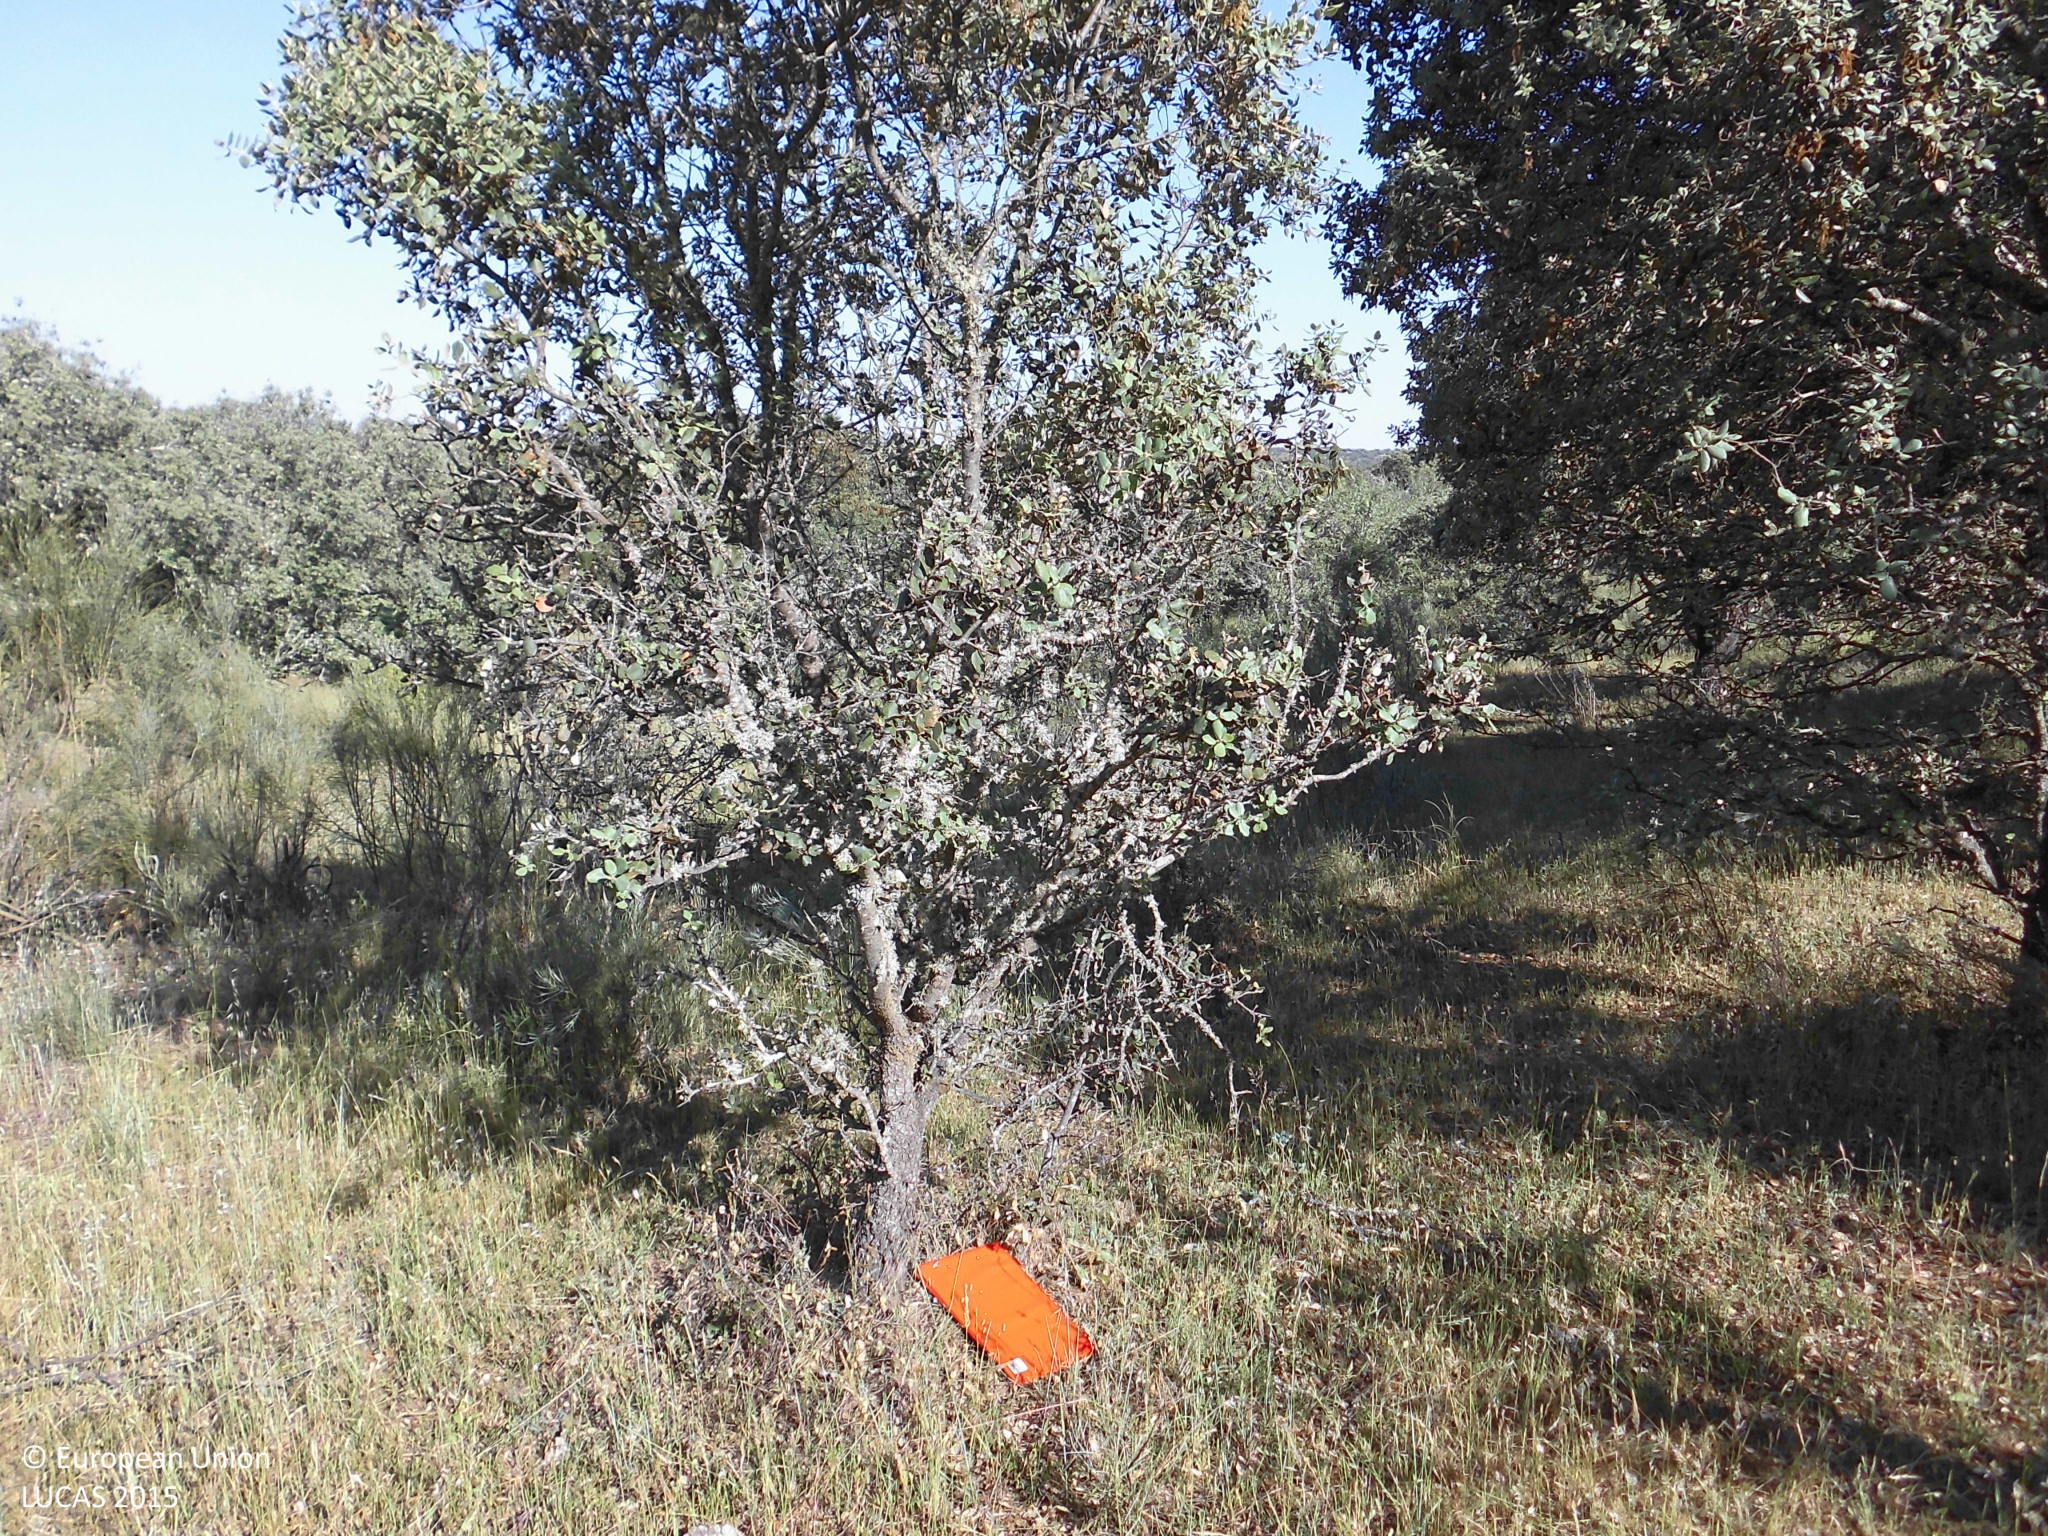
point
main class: Woodland
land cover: Broadleaved woodland
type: broadleaved evergreen forest
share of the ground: 25 - 50 %
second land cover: Grassland without tree/shrub cover
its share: > 75 %
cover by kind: herbaceous plants 55 %, broadleaved forest trees 40 %, shrubs 5 %
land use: Forestry
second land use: Agriculture (excluding fallow land and kitchen gardens)
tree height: > 5 m
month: May
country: ES
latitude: 39.5201
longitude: -6.0806
